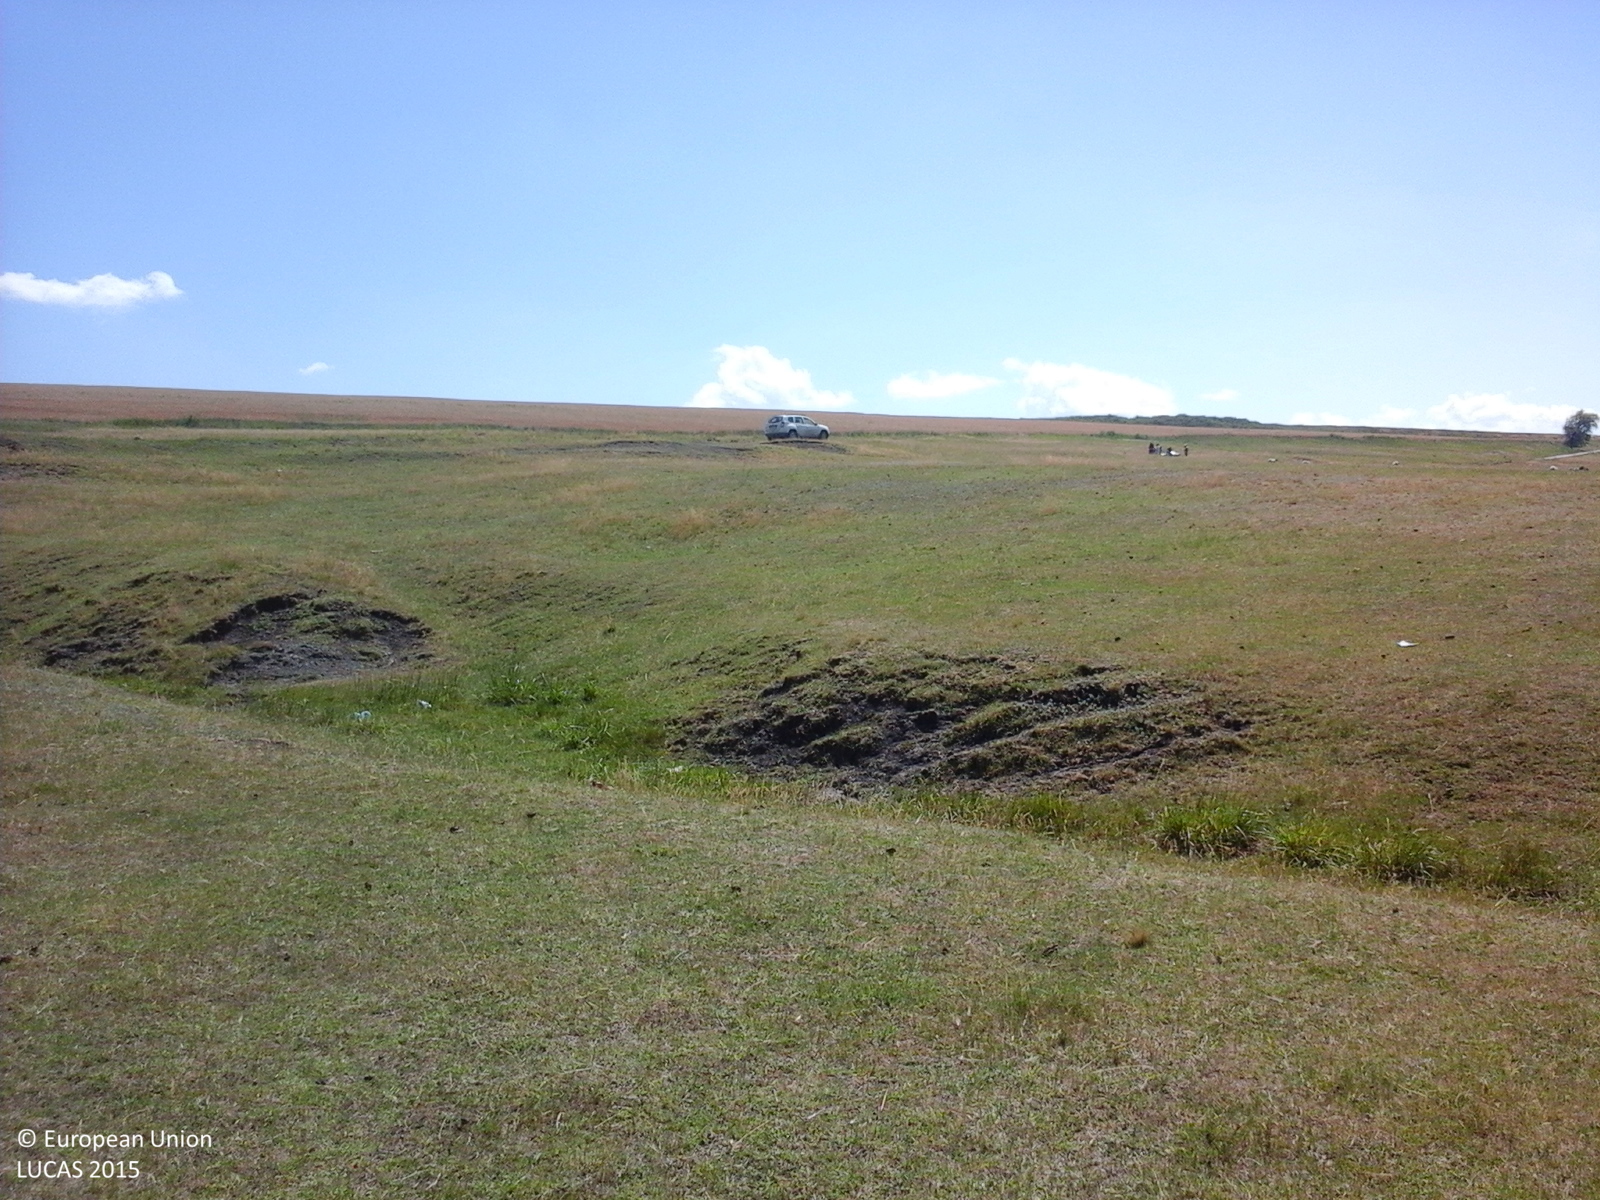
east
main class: Grassland
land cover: Grassland without tree/shrub cover
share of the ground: > 75 %
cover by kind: herbaceous plants 100 %
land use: Agriculture (excluding fallow land and kitchen gardens)
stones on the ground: 10 - 25 %
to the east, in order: Grassland without tree/shrub cover; Ditches and canals; Grassland without tree/shrub cover; Tracks; Grass margins; Ditches and canals; Grassland without tree/shrub cover; Common wheat
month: June
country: RO
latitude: 47.2440
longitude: 26.9713
